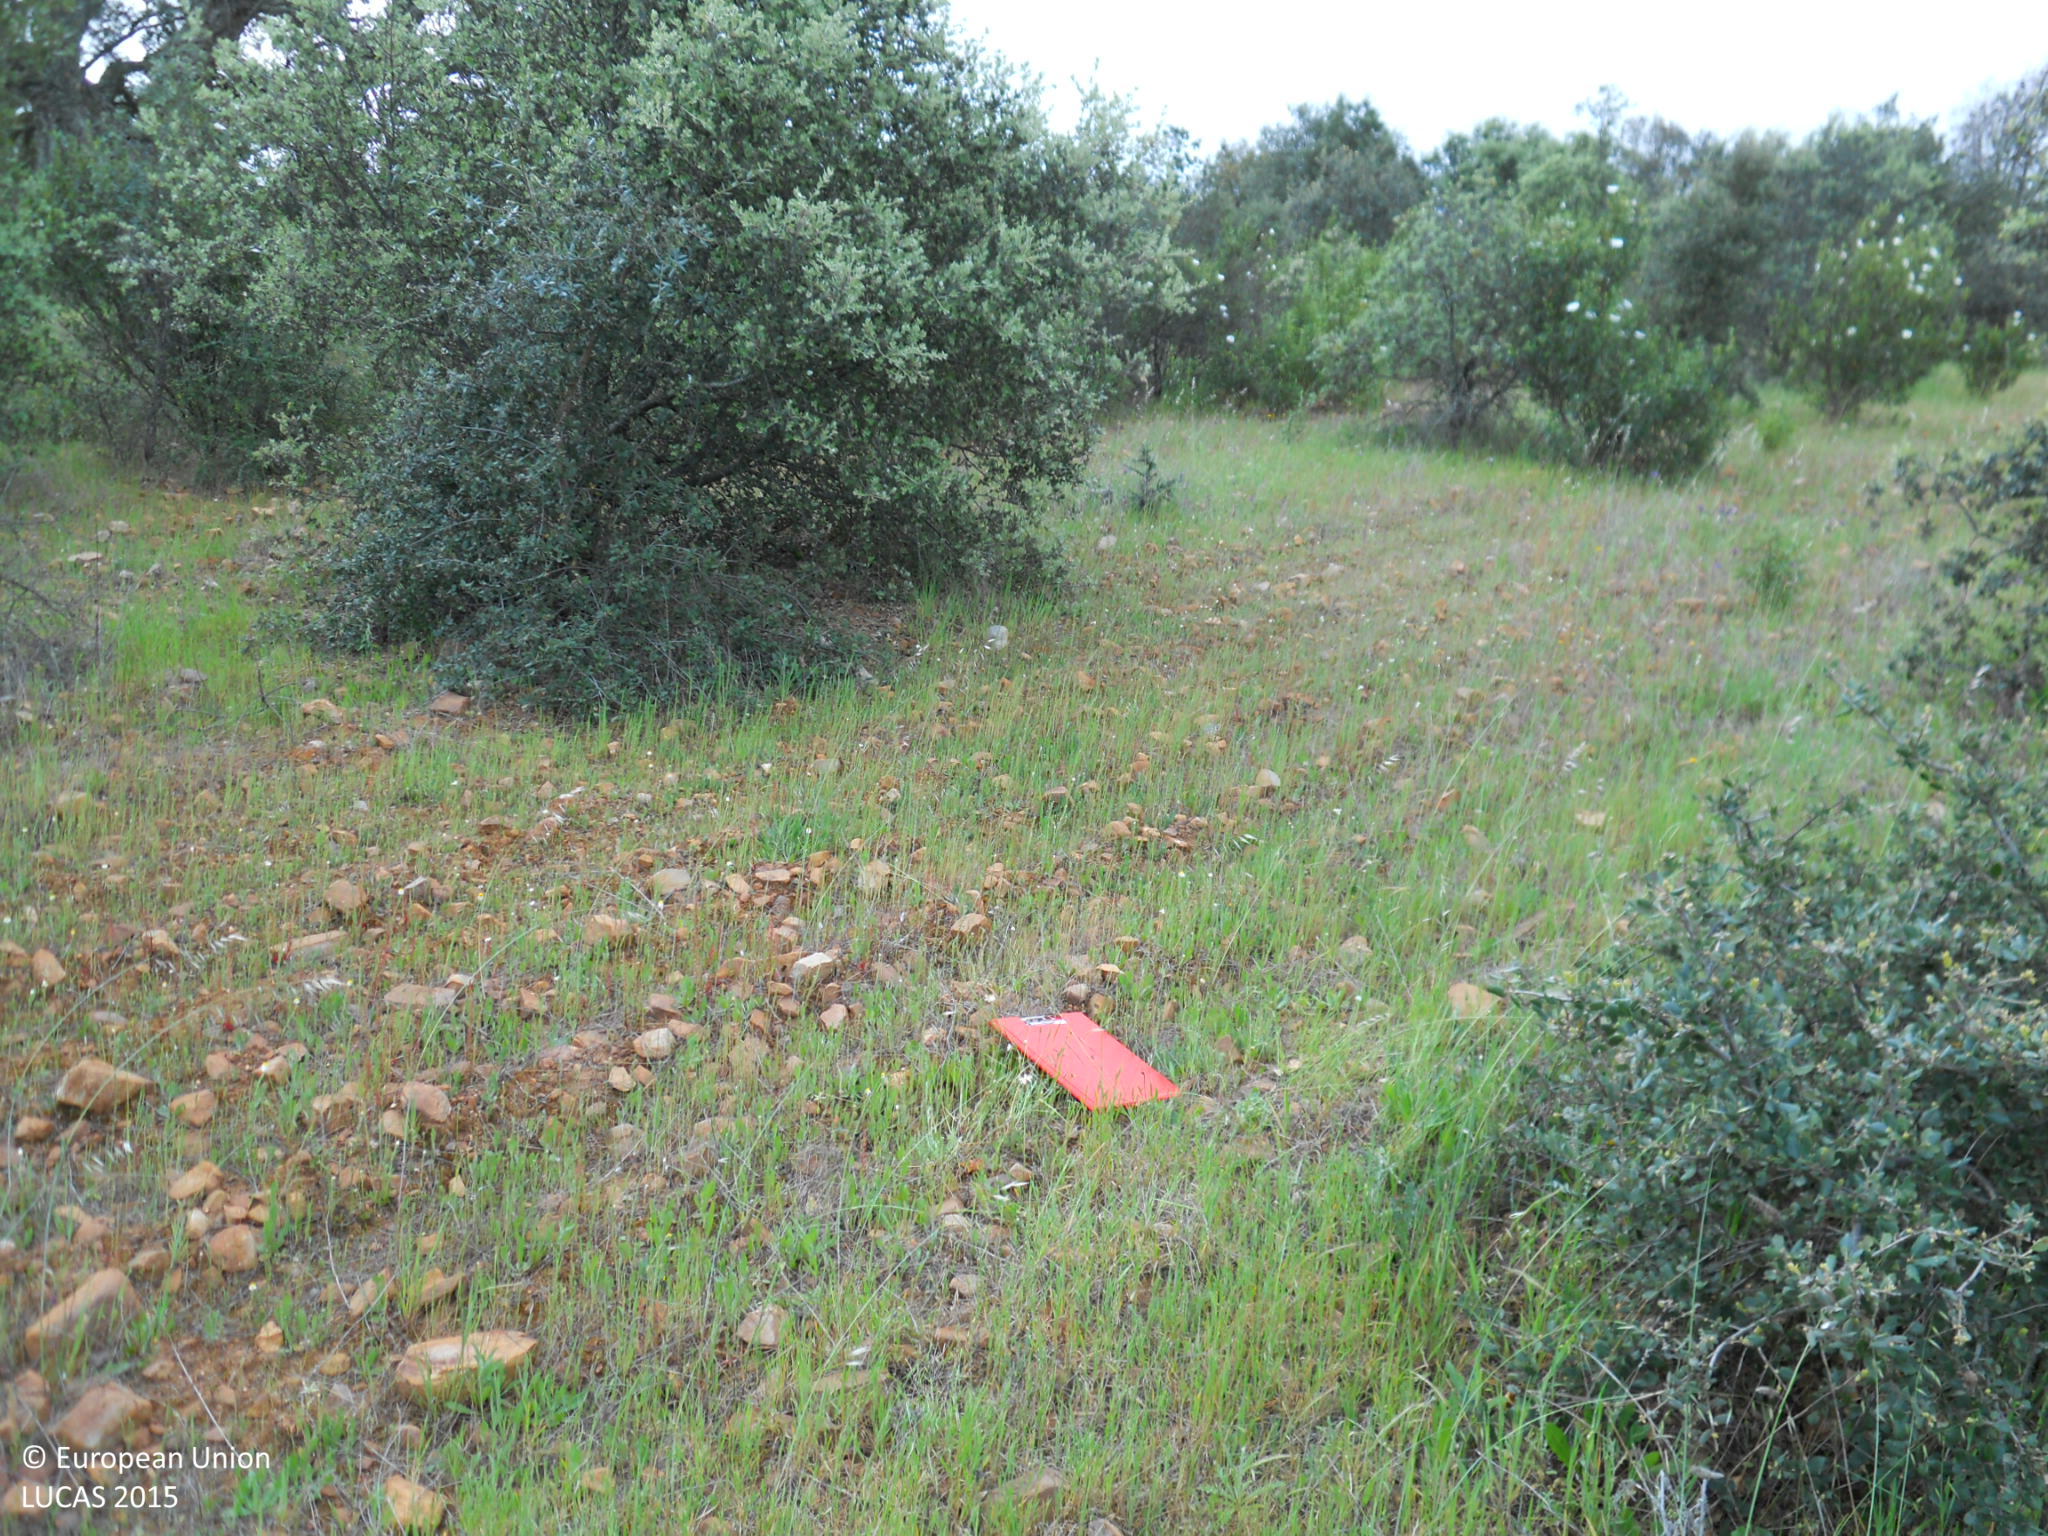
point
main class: Woodland
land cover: Broadleaved woodland
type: broadleaved evergreen forest
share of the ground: > 75 %
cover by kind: broadleaved forest trees 40 %, unconsolidated bare surface 40 %, shrubs 20 %
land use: Forestry
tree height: < 5 m
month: April
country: ES
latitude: 39.1096
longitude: -6.5446
